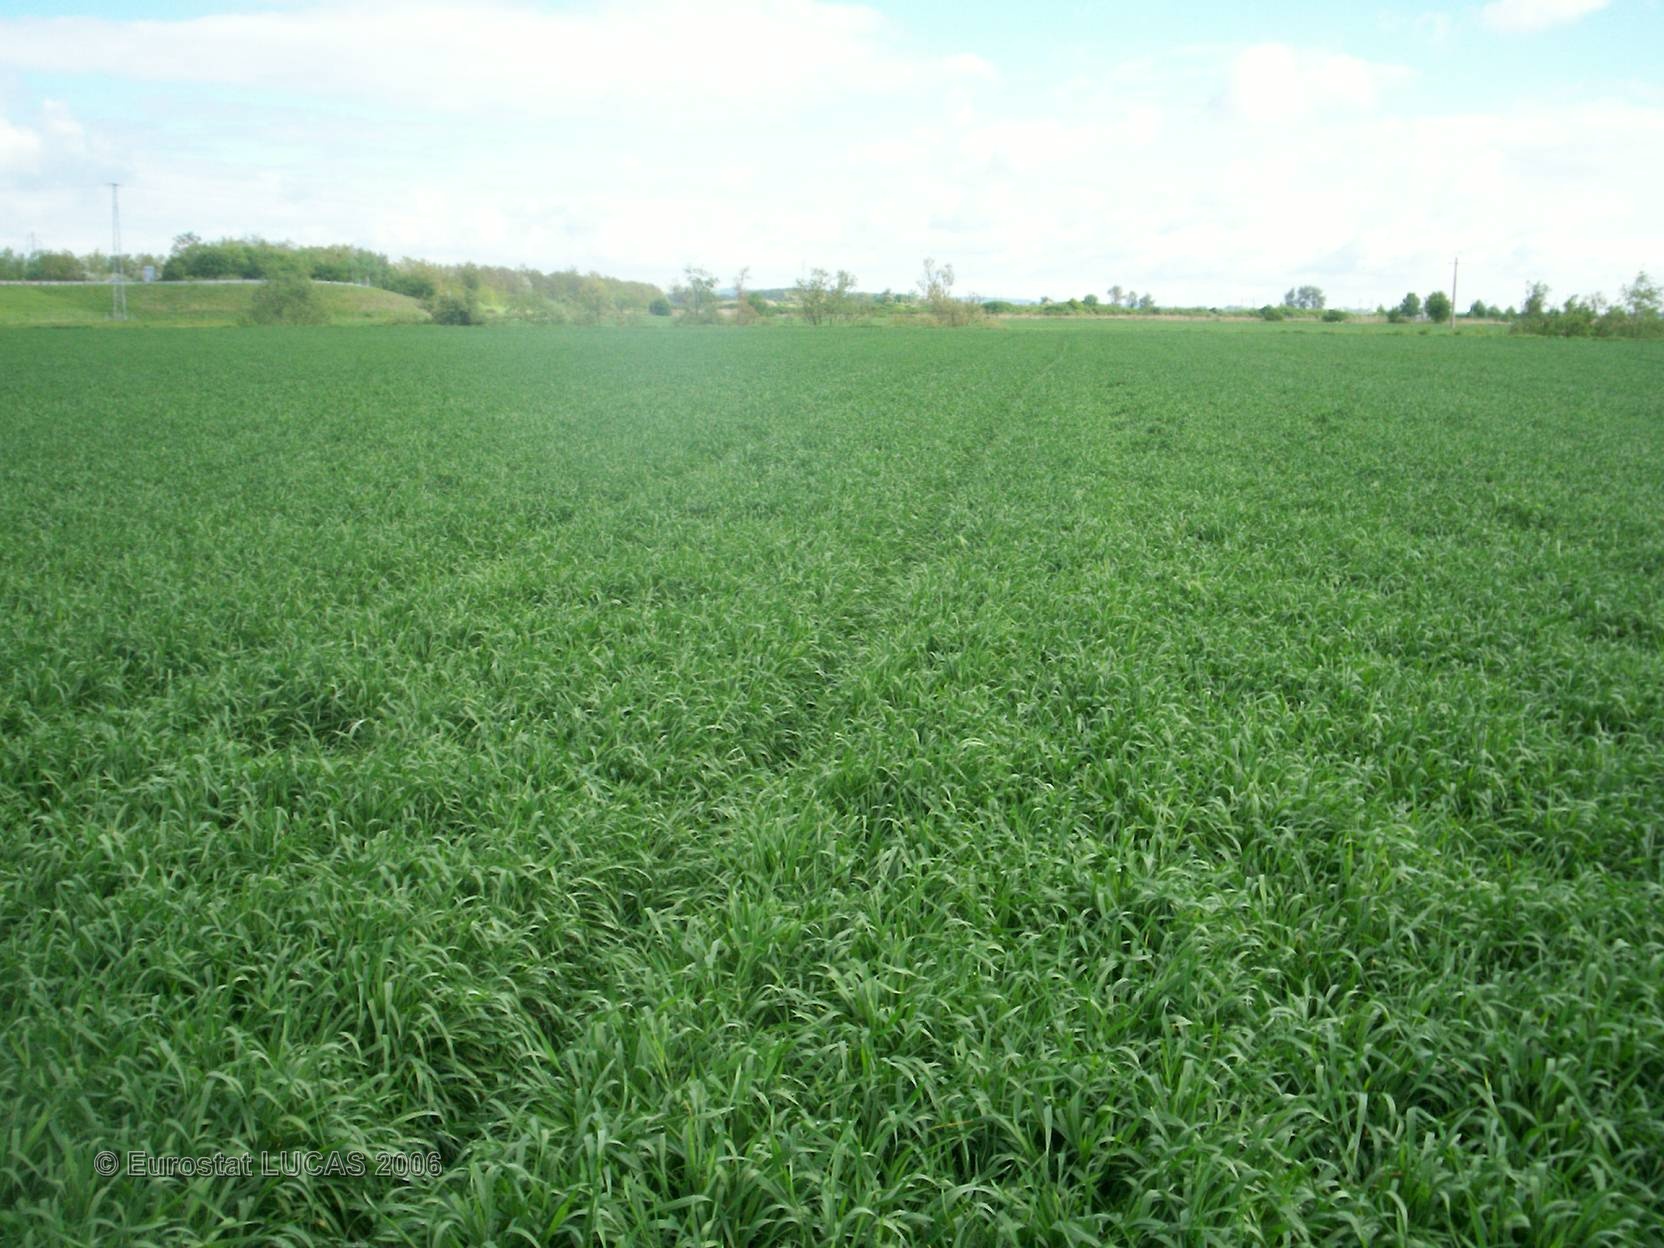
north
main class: Cropland
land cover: Barley
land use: Agriculture (excluding fallow land and kitchen gardens)
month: May
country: FR
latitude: 45.8969
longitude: 3.1557
